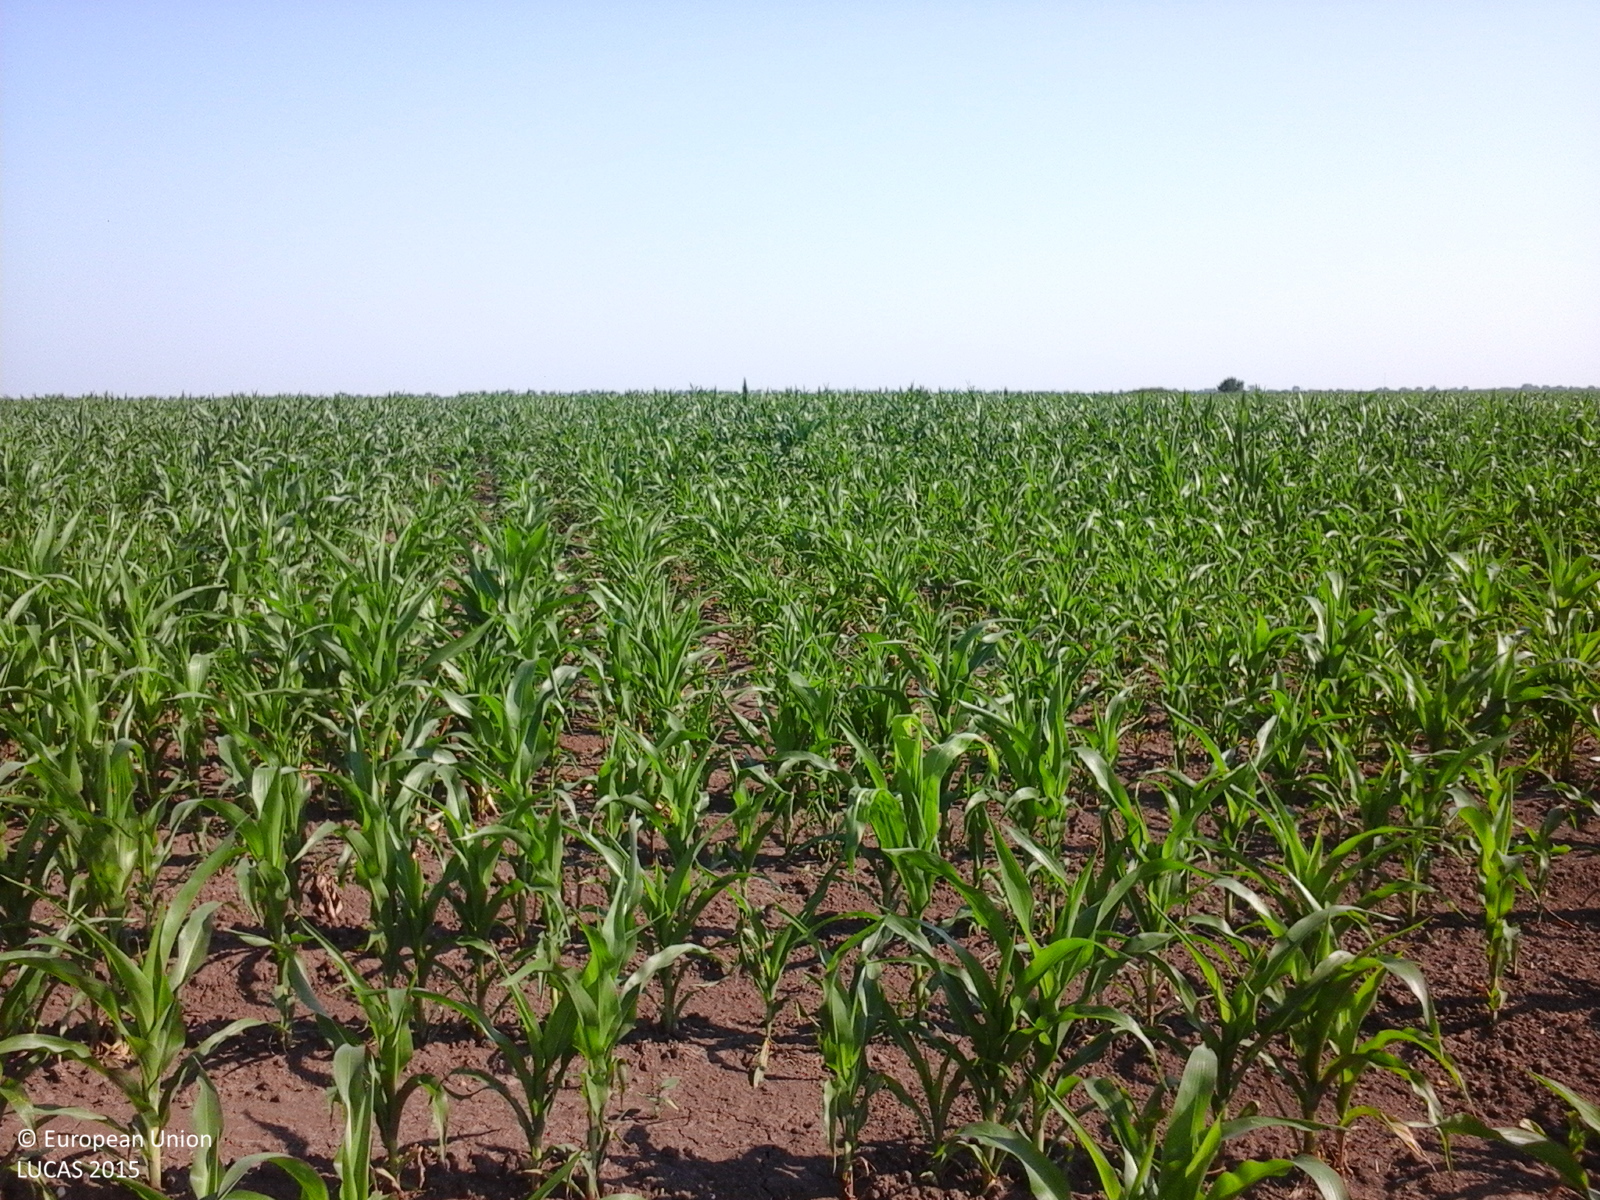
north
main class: Cropland
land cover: Maize
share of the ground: > 75 %
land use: Agriculture (excluding fallow land and kitchen gardens)
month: July
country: RO
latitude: 44.6492
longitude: 24.8446
